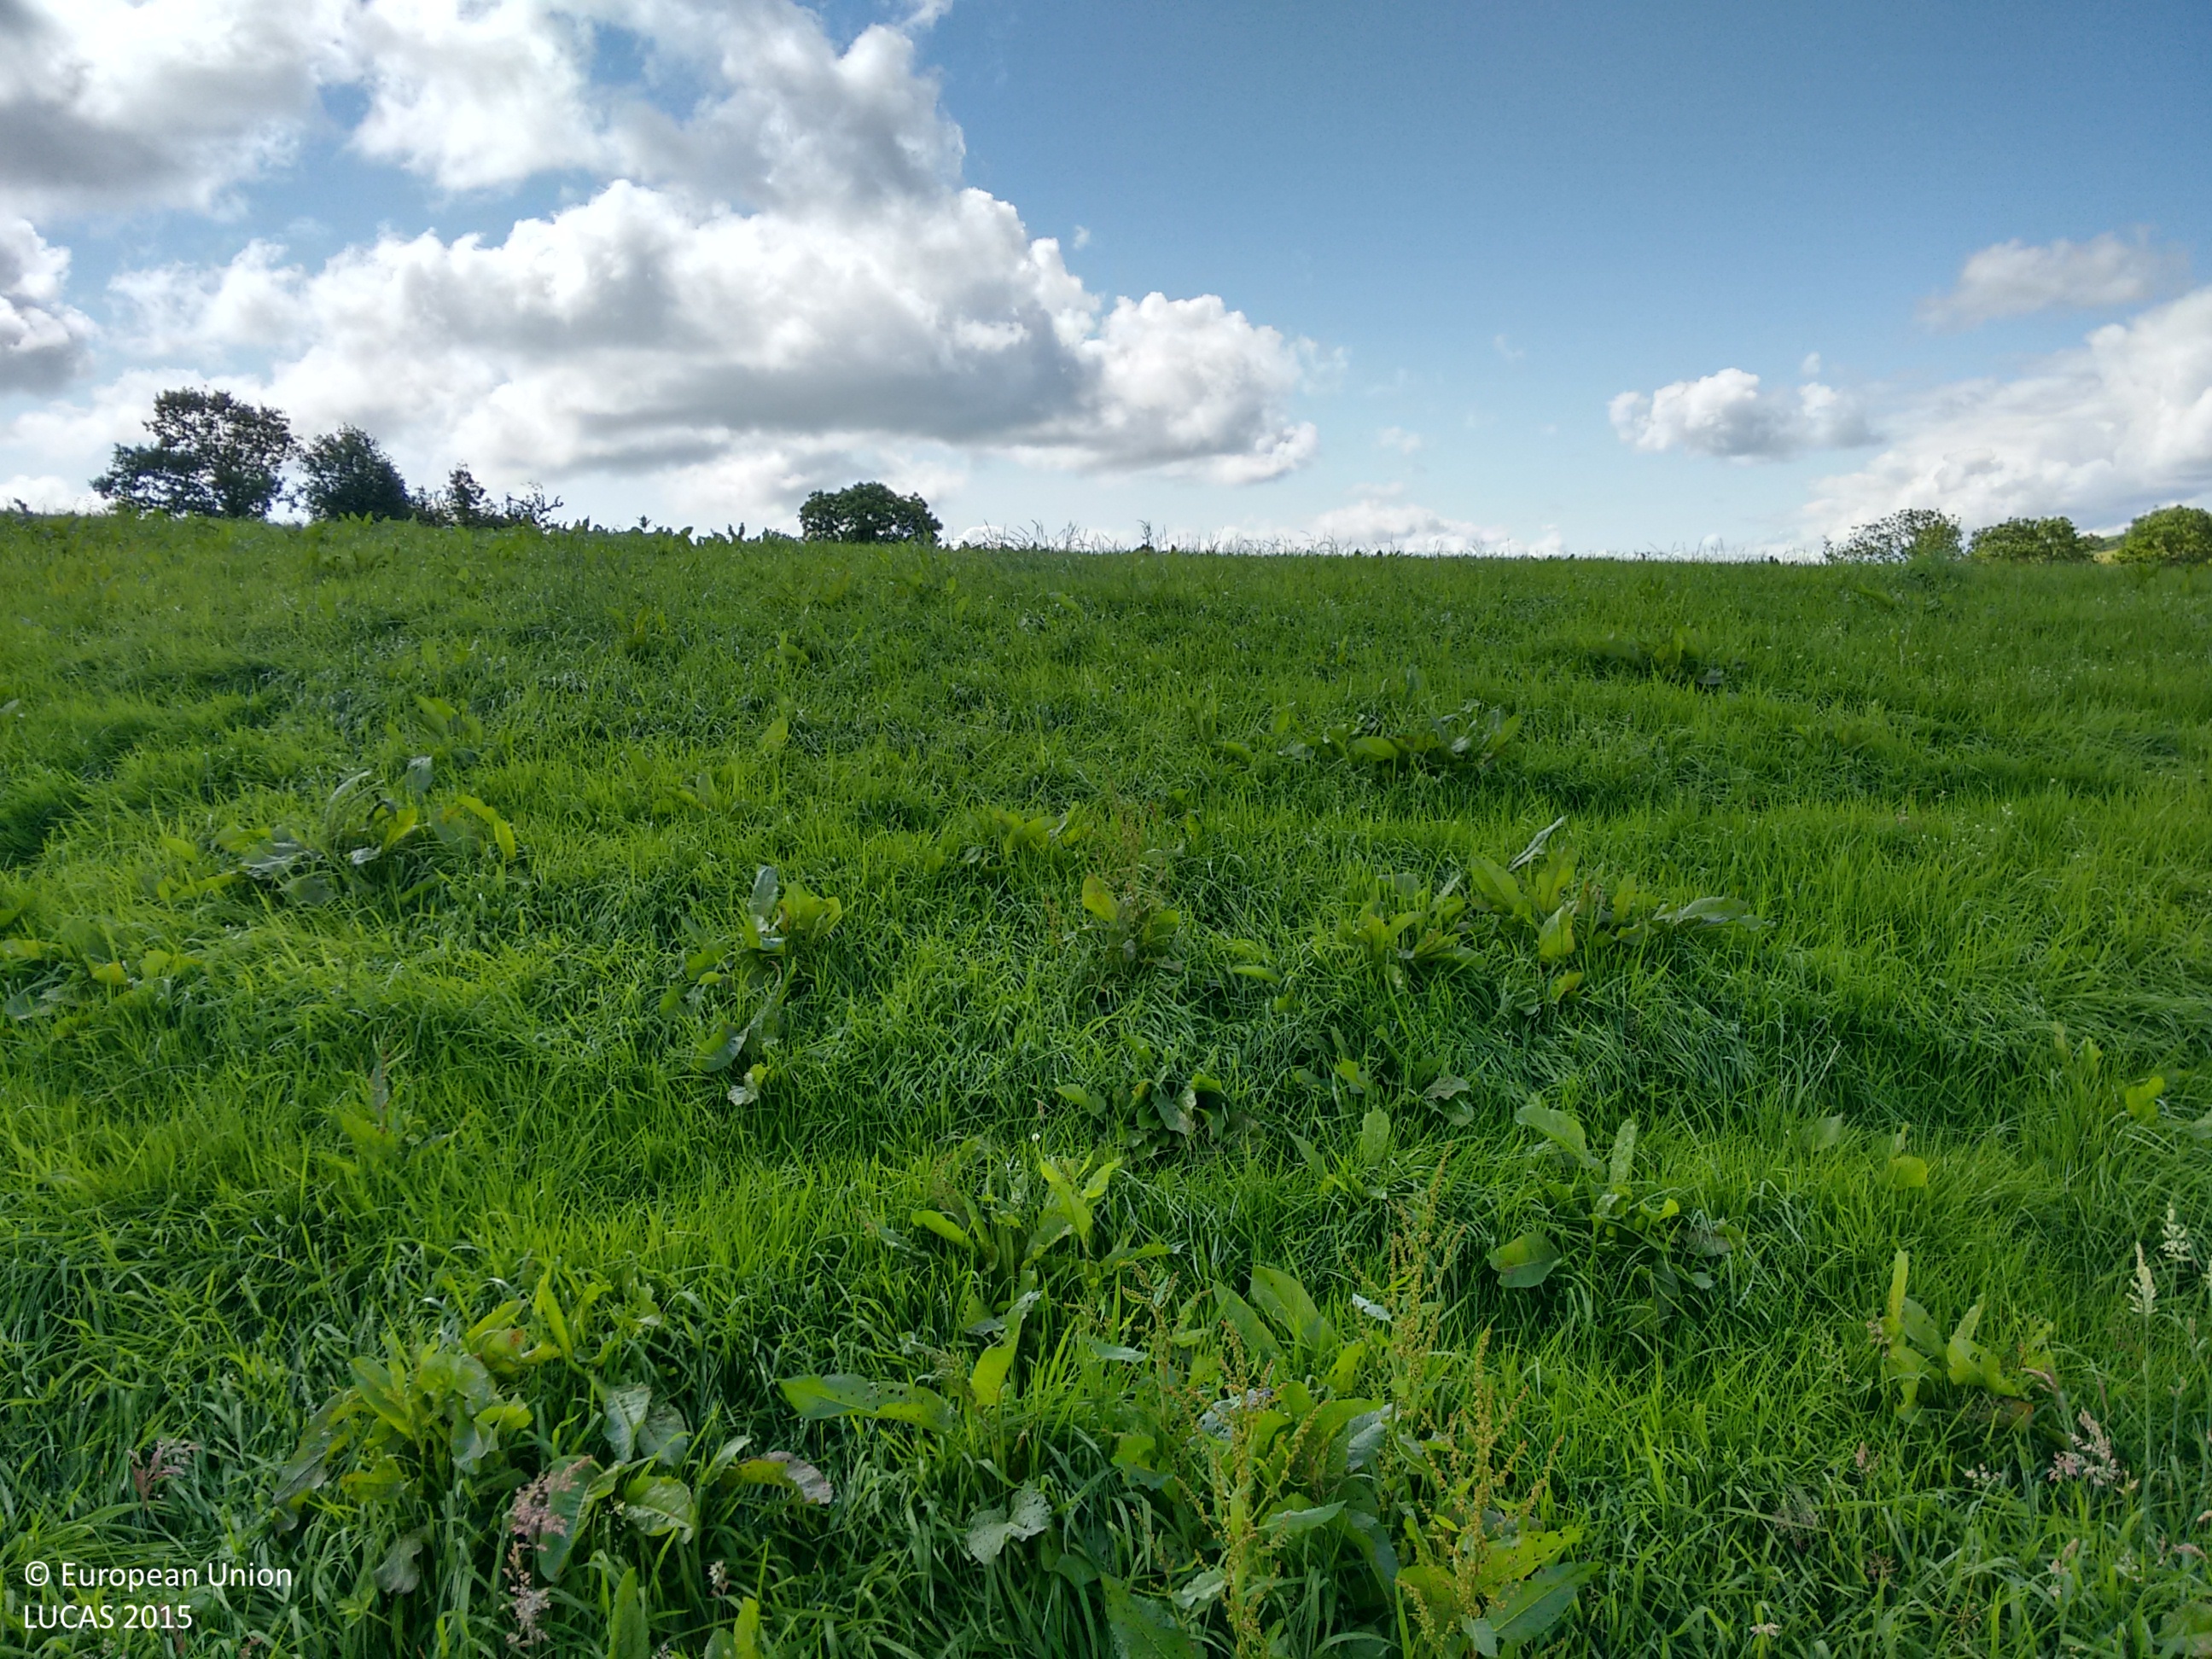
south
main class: Grassland
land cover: Grassland without tree/shrub cover
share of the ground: > 75 %
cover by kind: herbaceous plants 95 %, shrubs 5 %
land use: Agriculture (excluding fallow land and kitchen gardens)
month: July
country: IE
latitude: 52.8407
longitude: -8.4064
